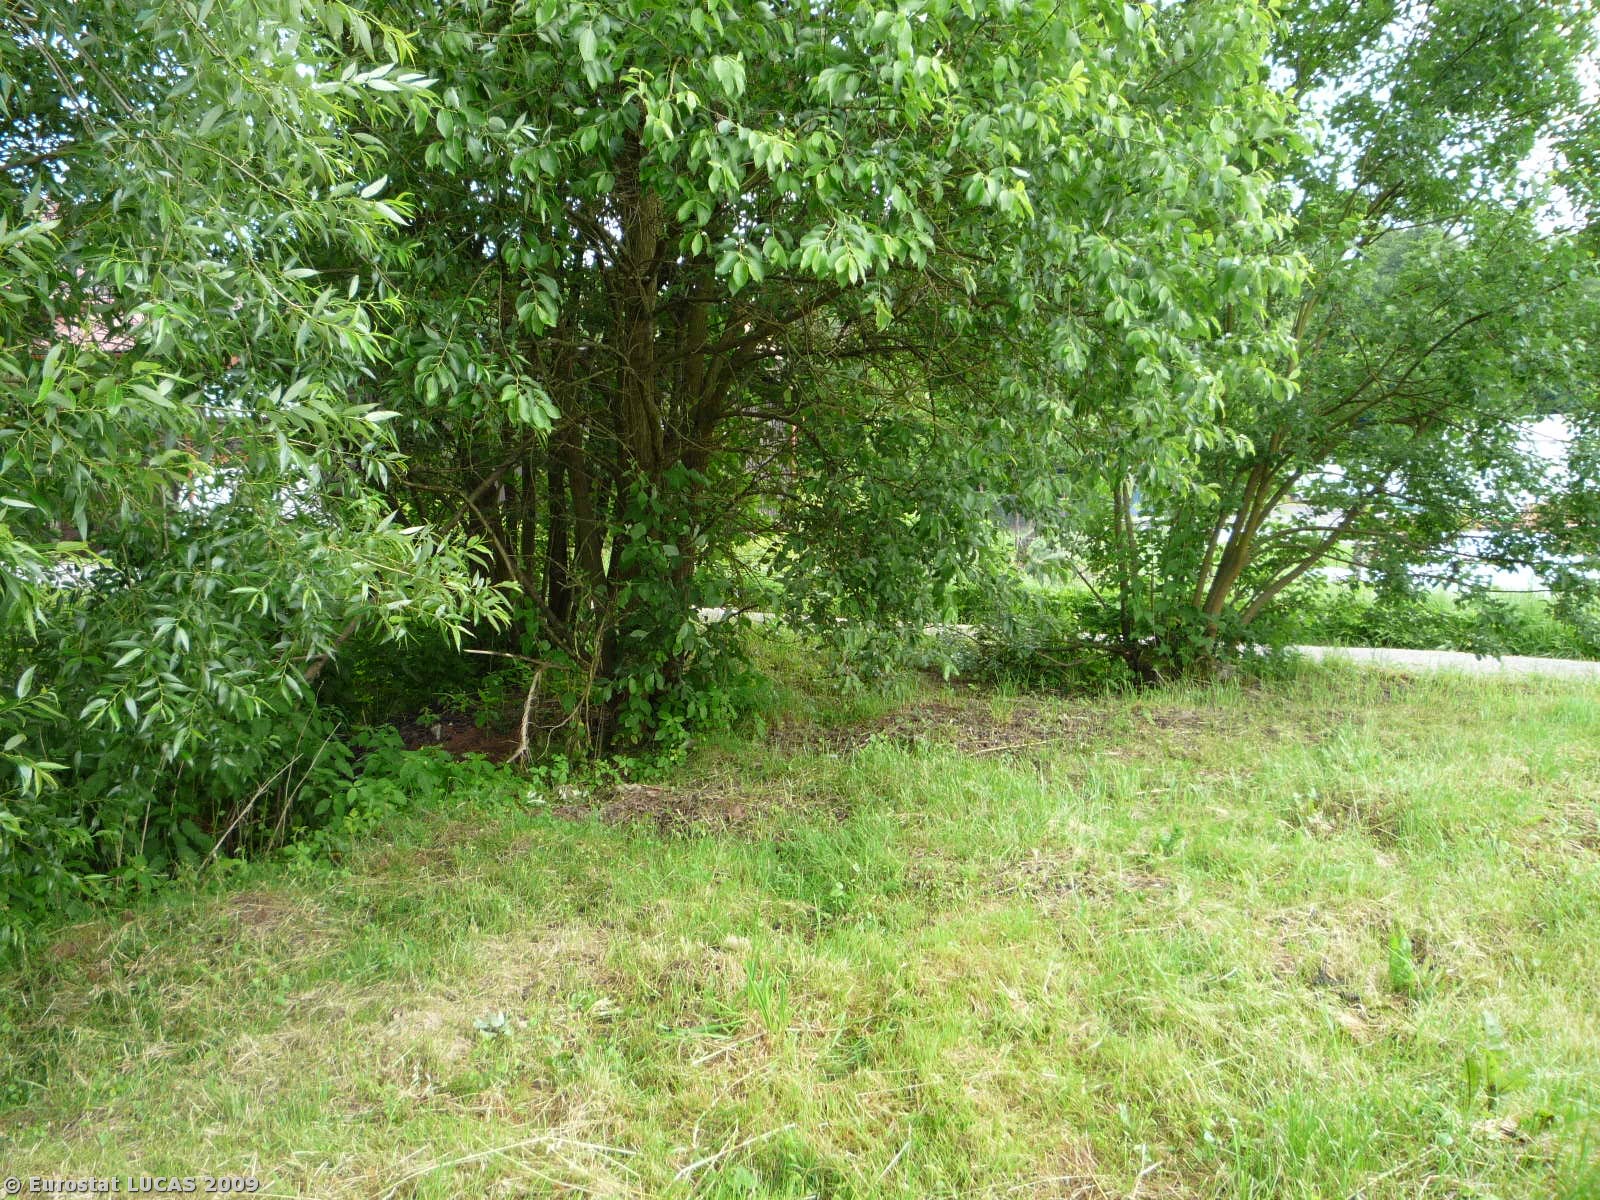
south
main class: Grassland
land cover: Grassland without tree/shrub cover
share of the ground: > 75 %
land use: Unused
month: June
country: CZ
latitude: 50.5564
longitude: 15.4950
